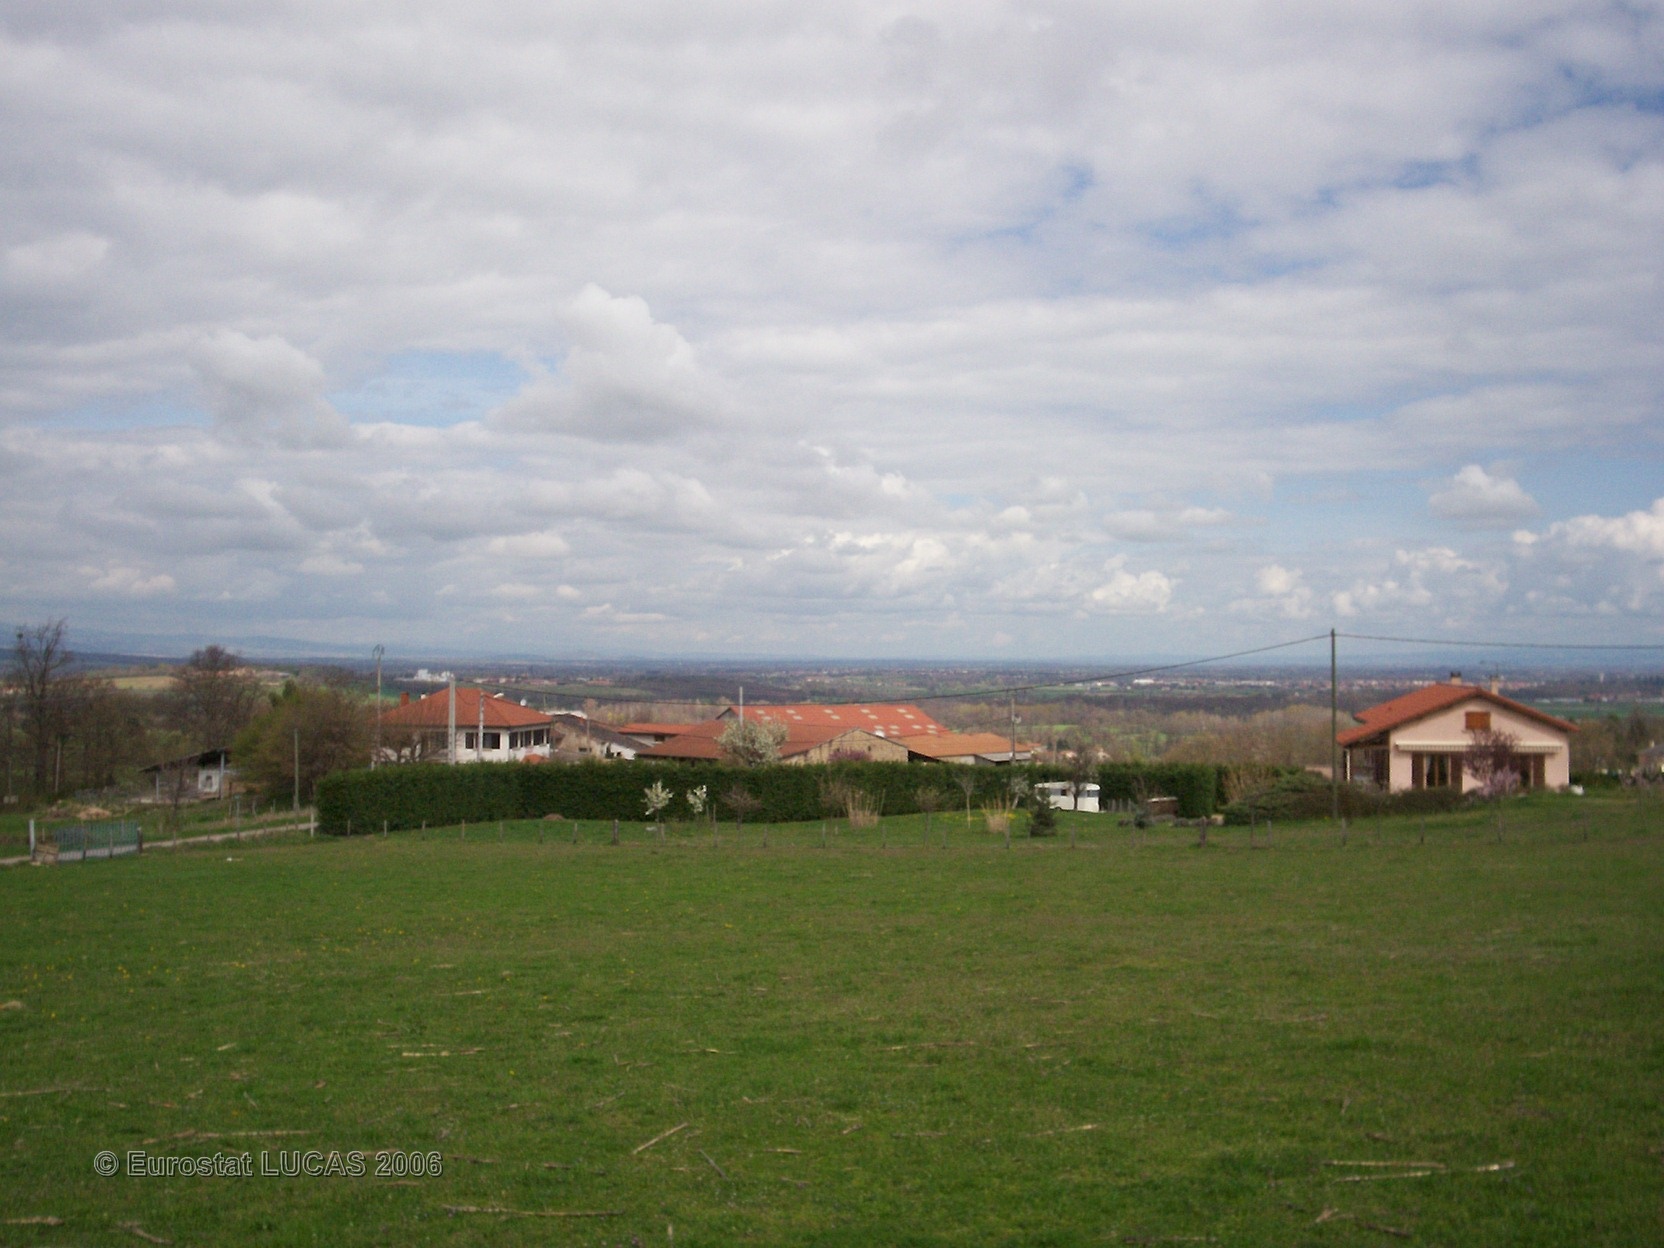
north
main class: Grassland
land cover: Grassland without tree/shrub cover
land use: Agriculture (excluding fallow land and kitchen gardens)
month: April
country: FR
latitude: 45.4719
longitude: 4.2090
